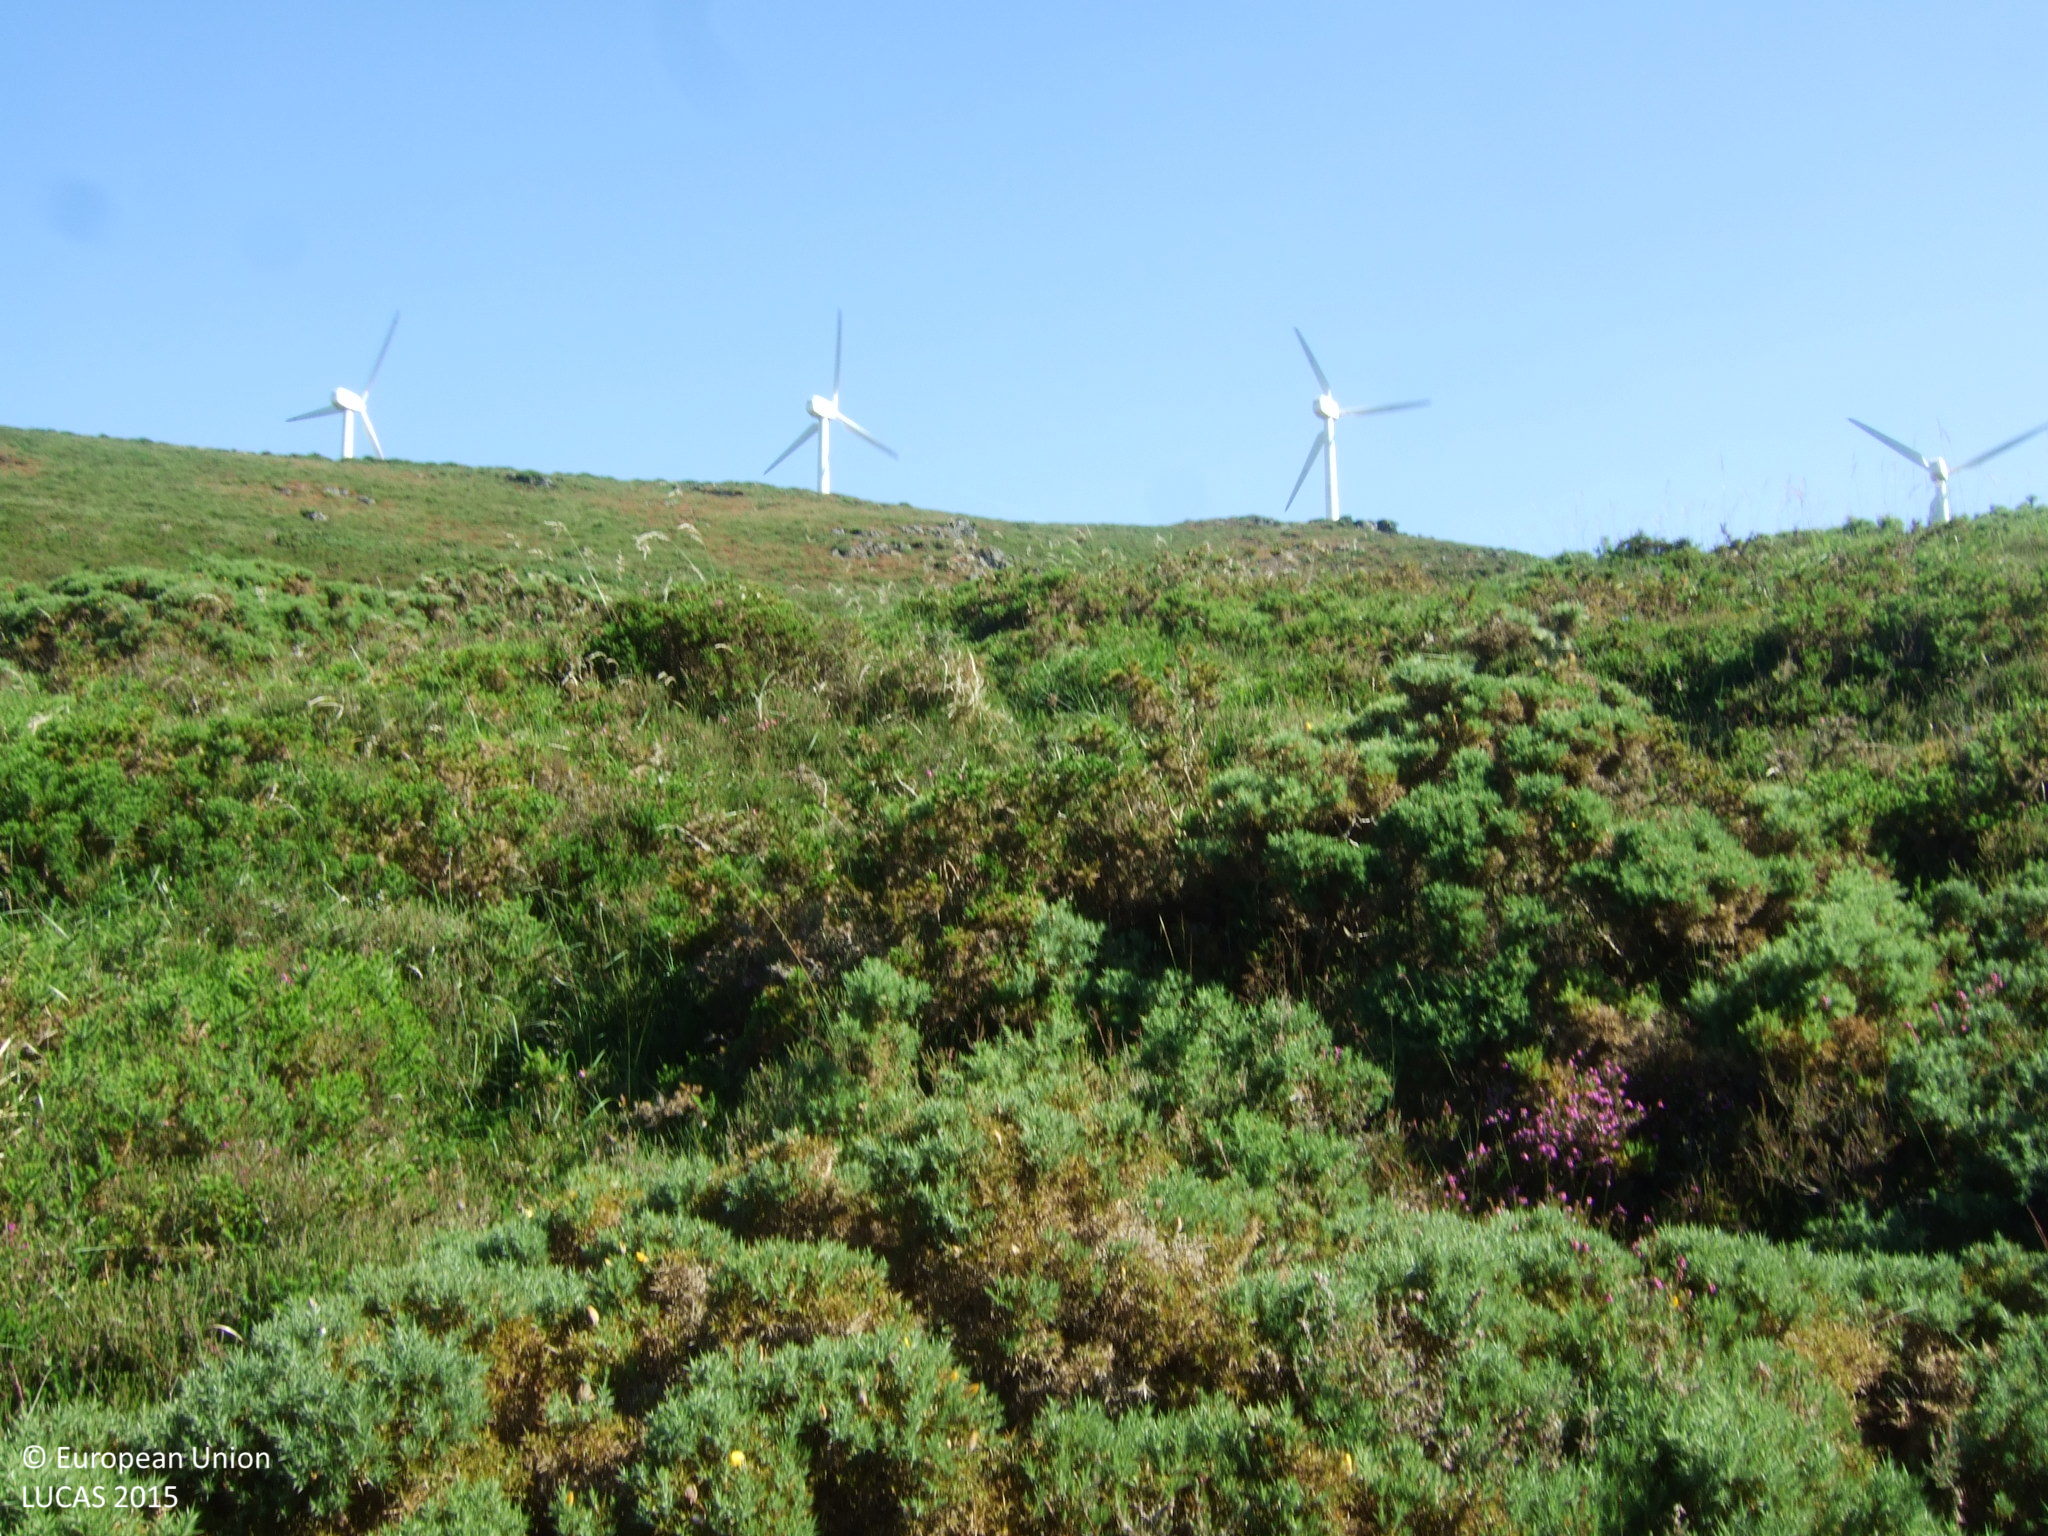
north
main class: Shrubland
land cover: Shrubland without tree cover
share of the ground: > 75 %
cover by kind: shrubs 90 %, herbaceous plants 10 %
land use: Semi-natural and natural areas not in use
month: June
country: ES
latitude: 43.4901
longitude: -7.7337
